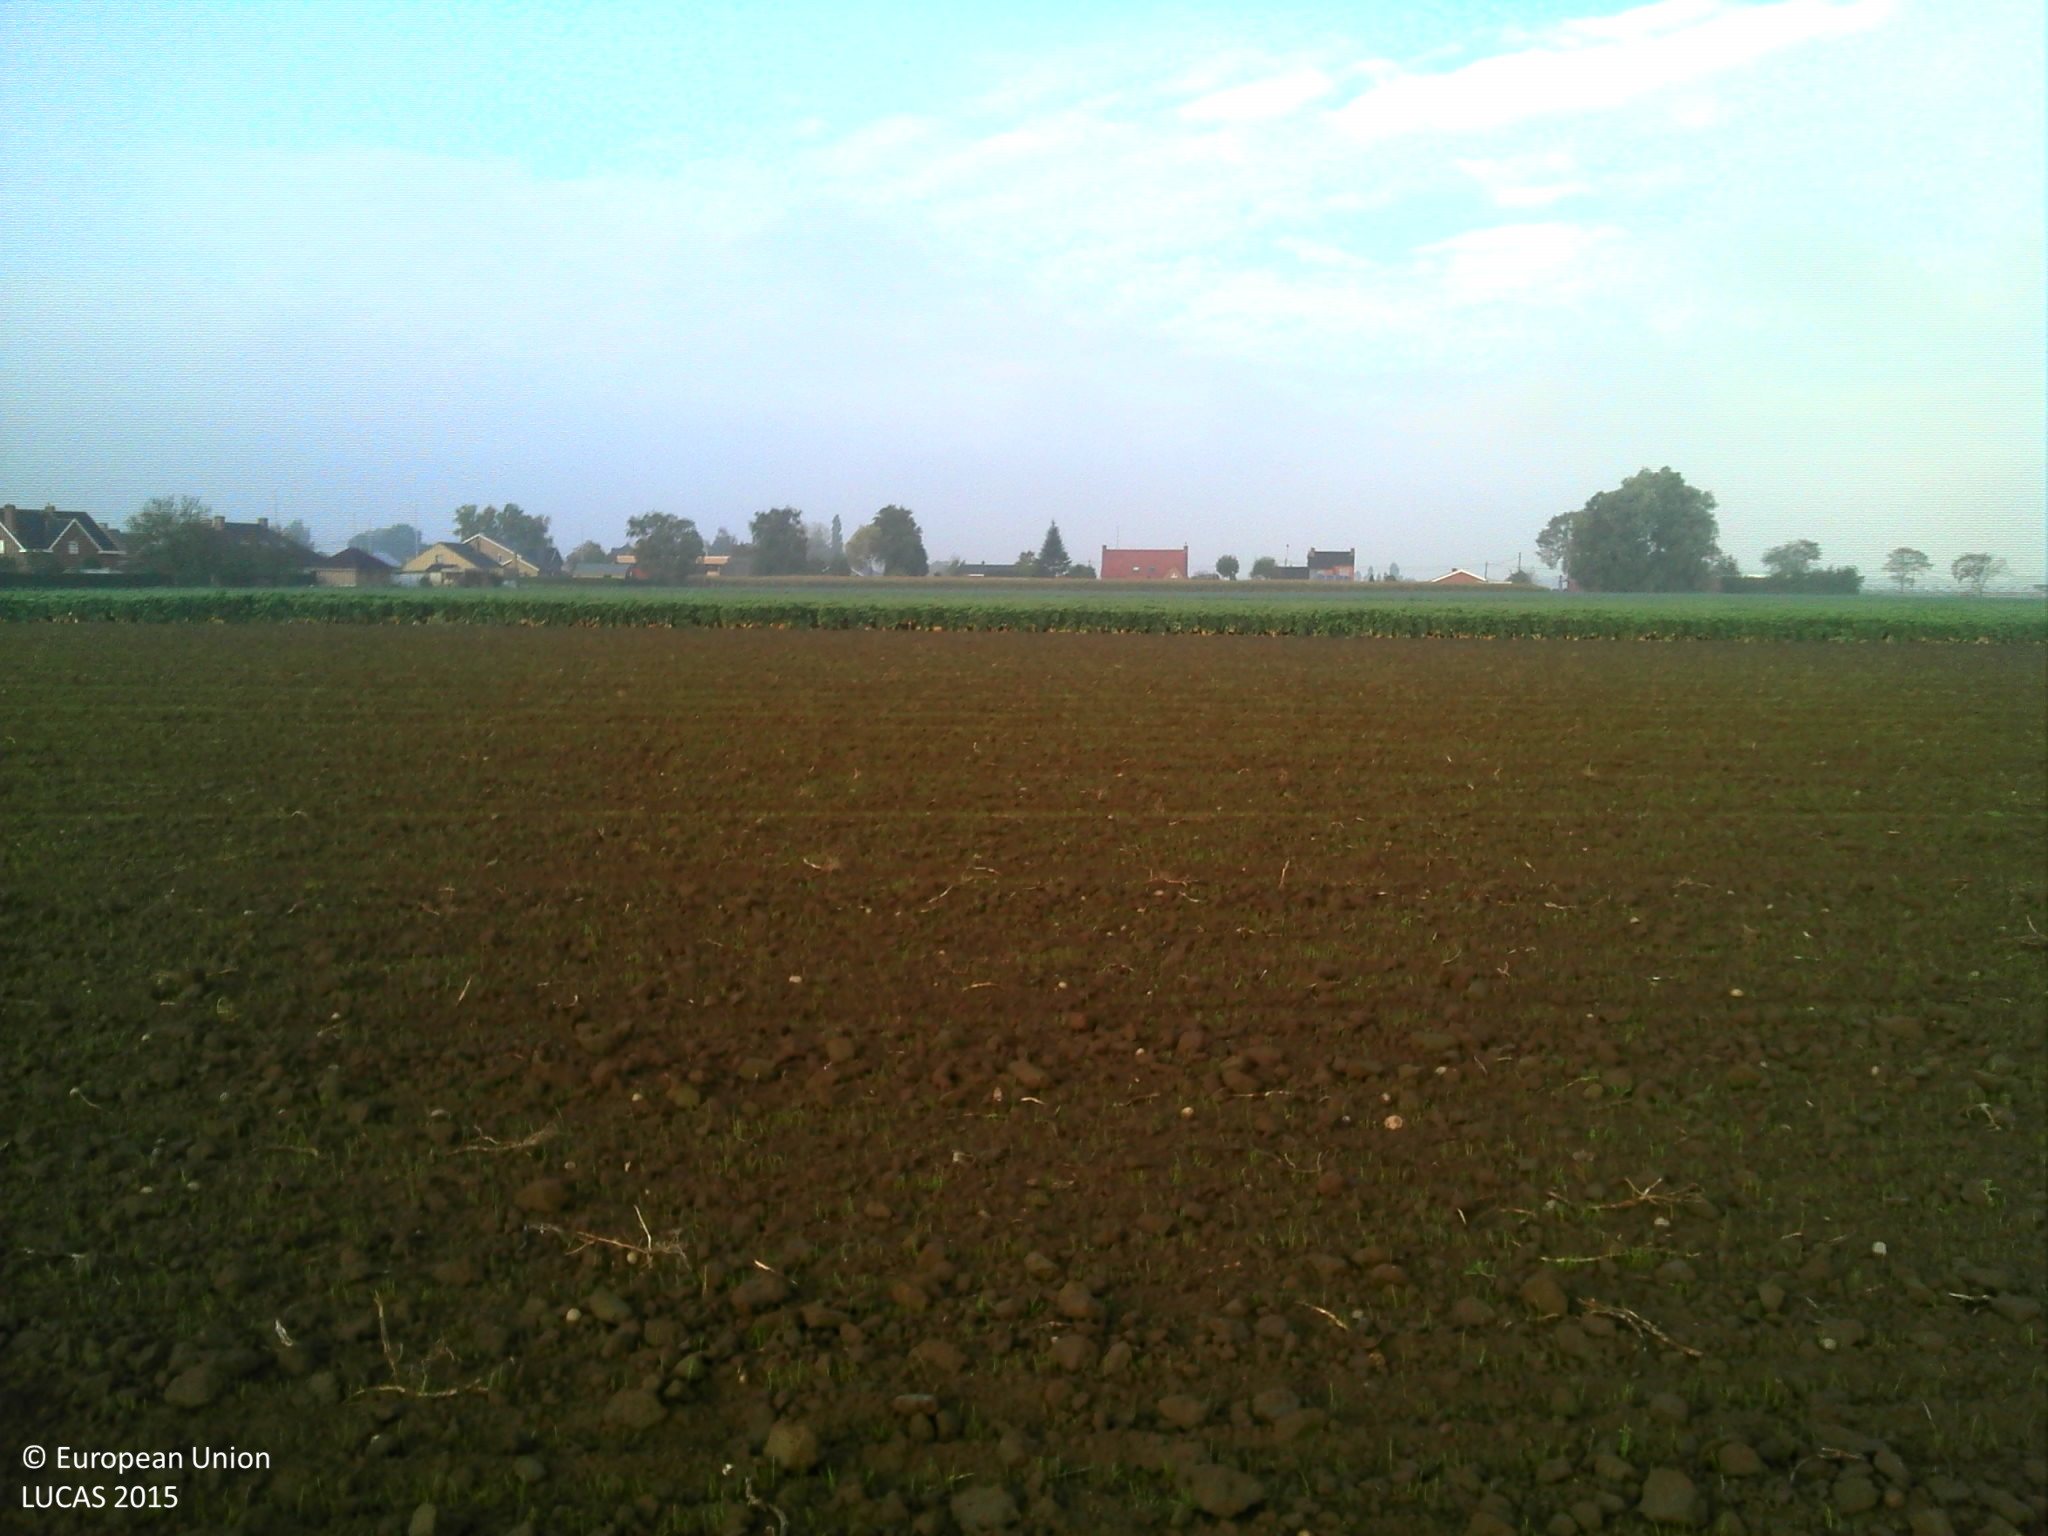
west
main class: Cropland
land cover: Temporary grasslands
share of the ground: < 10 %
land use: Agriculture (excluding fallow land and kitchen gardens)
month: October
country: BE
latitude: 50.9403
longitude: 2.9451
